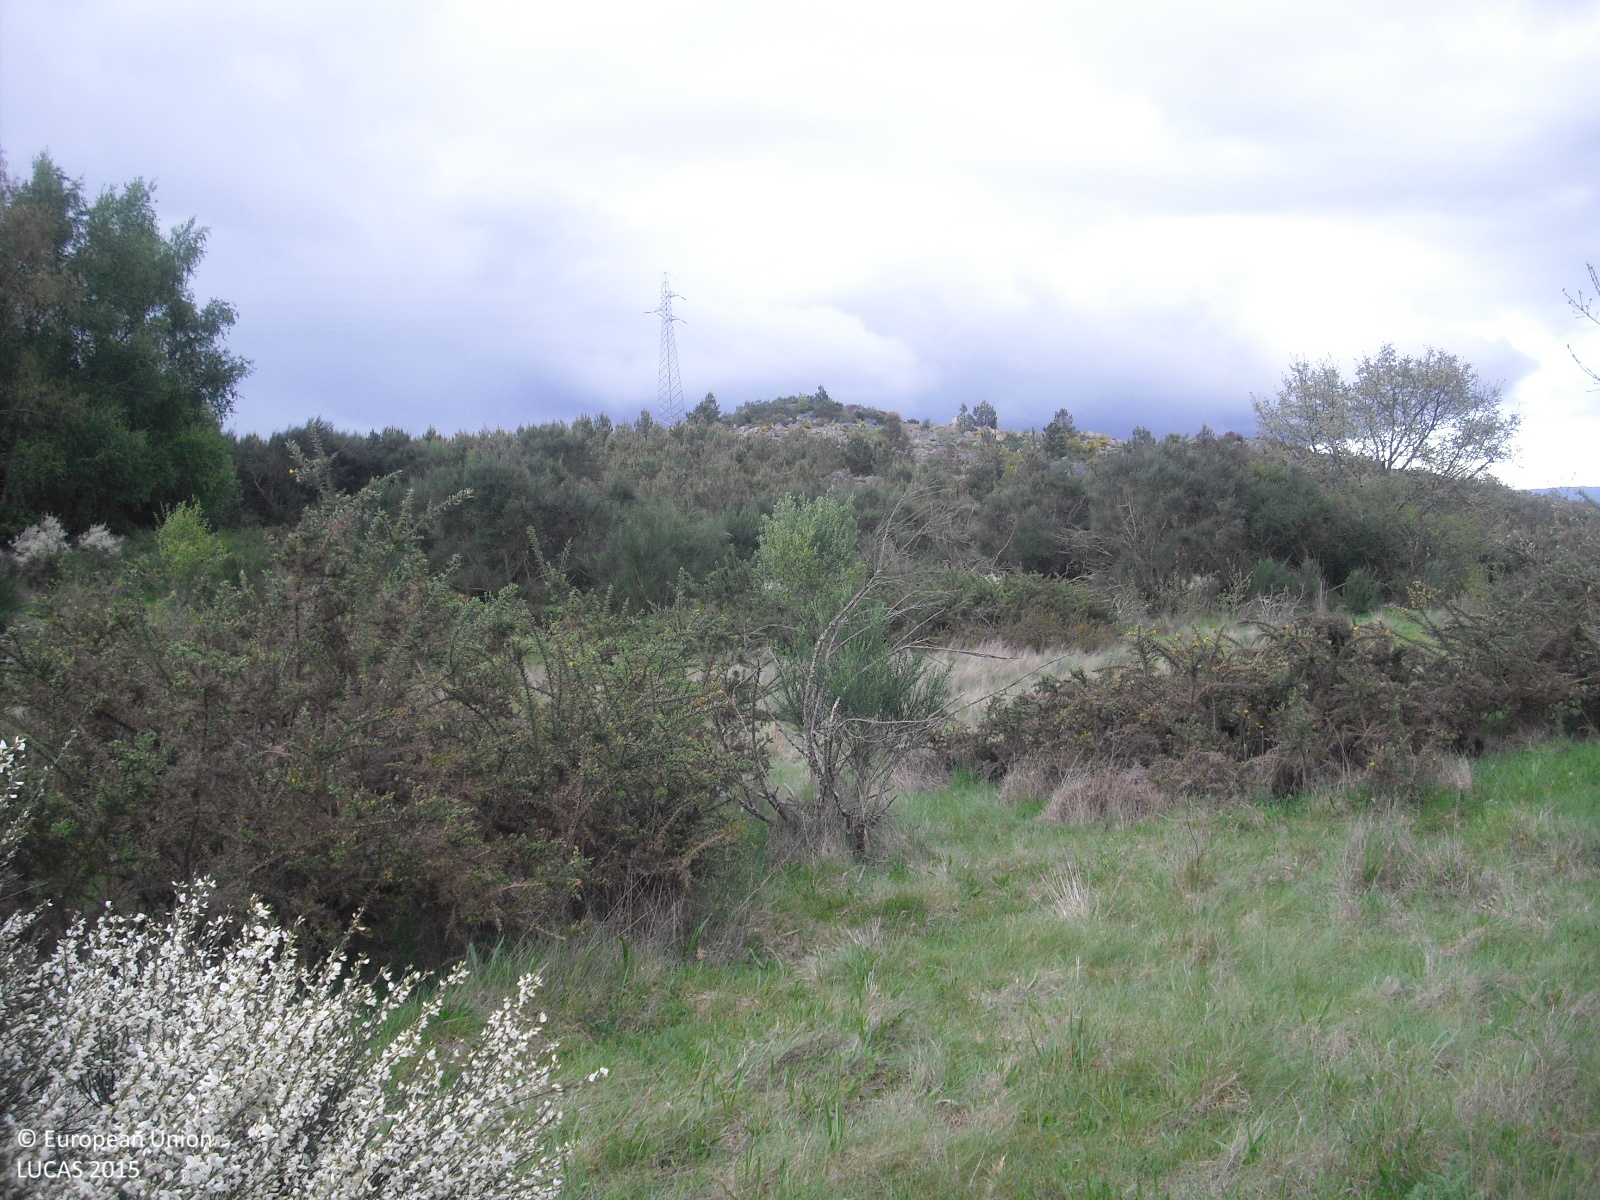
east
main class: Shrubland
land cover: Shrubland with sparse tree cover
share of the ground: 50 - 75 %
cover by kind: herbaceous plants 55 %, shrubs 40 %, broadleaved forest trees 5 %
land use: Agriculture (excluding fallow land and kitchen gardens)
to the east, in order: Shrubland with sparse tree cover; Ditches and canals; Grassland with sparse tree/shrub cover; Shrubland without tree cover; Dry stone walls; Grass margins; Ditches and canals; Shruby margins; Tracks; Pine dominated coniferous woodland; Rock outcrops; Pine dominated coniferous woodland; Rocks and stones; Broadleaved woodland; Shrubland with sparse tree cover; Rocks and stones
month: April
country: ES
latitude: 41.9433
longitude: -7.5159
